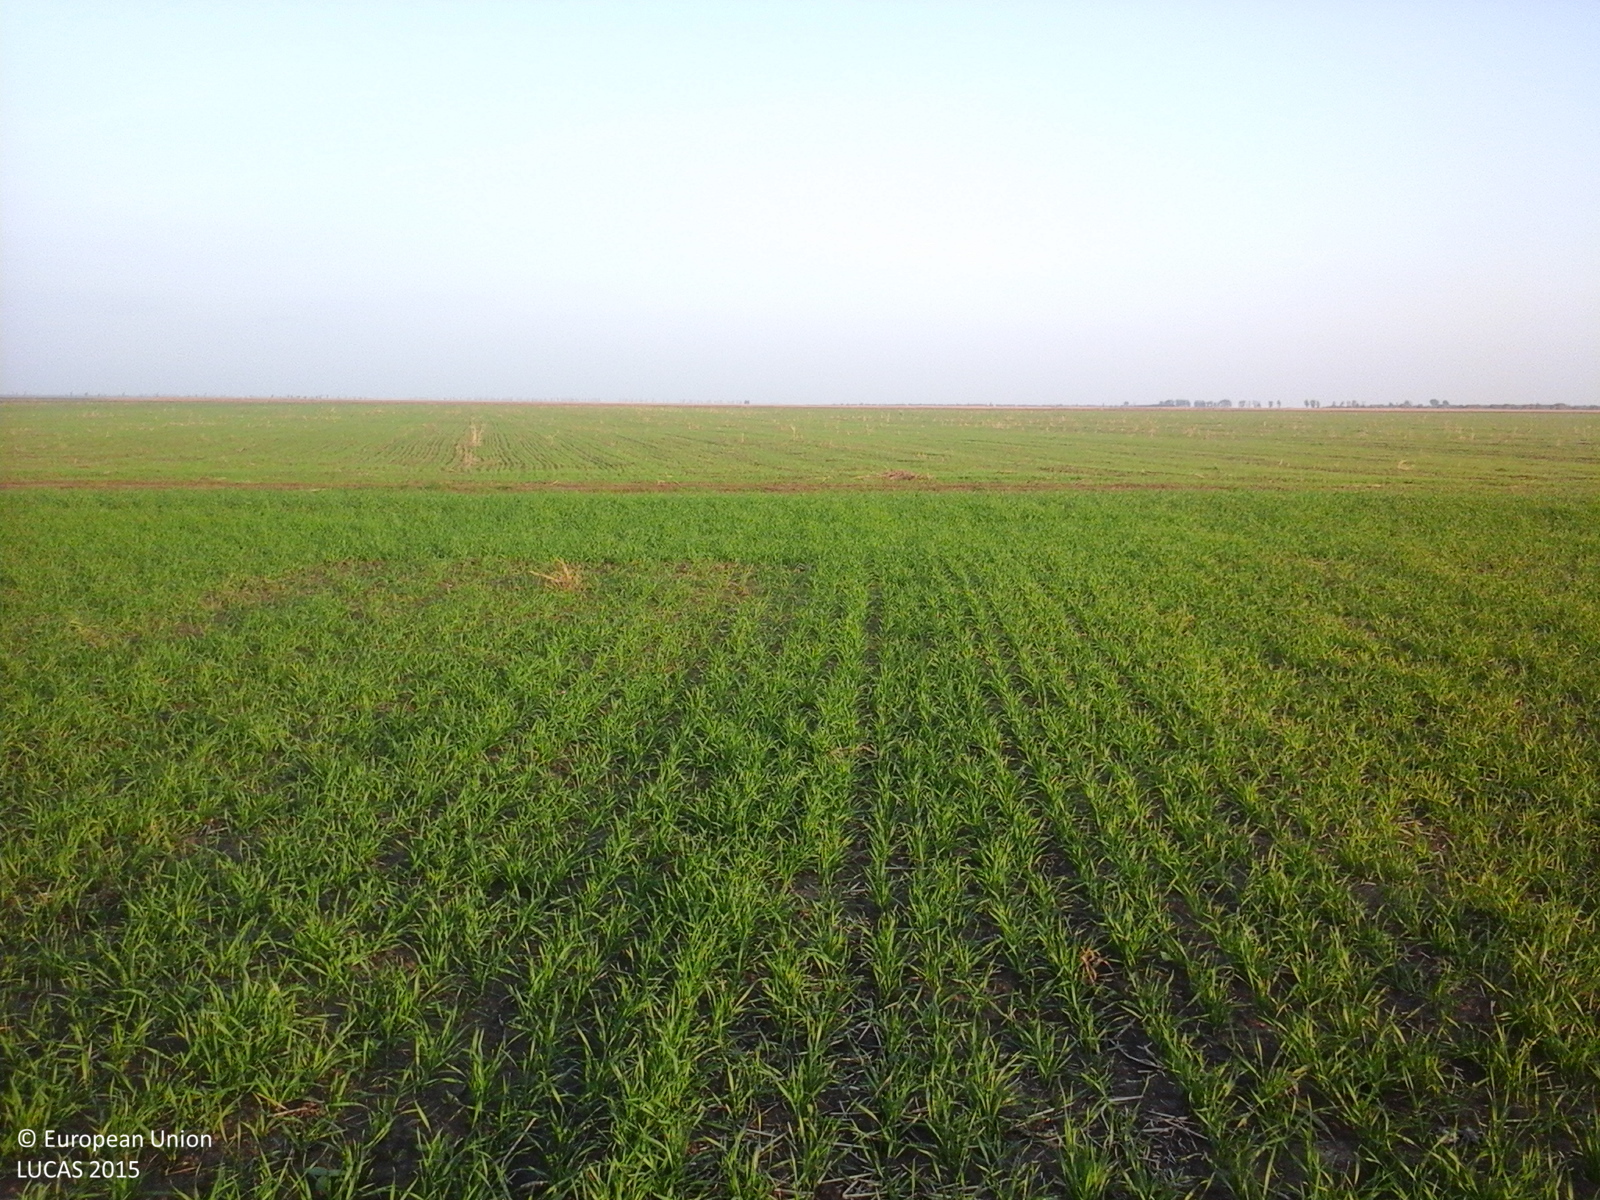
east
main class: Cropland
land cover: Common wheat
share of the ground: > 75 %
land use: Agriculture (excluding fallow land and kitchen gardens)
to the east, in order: Common wheat; Tracks; Grass margins; Common wheat
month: October
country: RO
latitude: 45.2327
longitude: 27.0141
